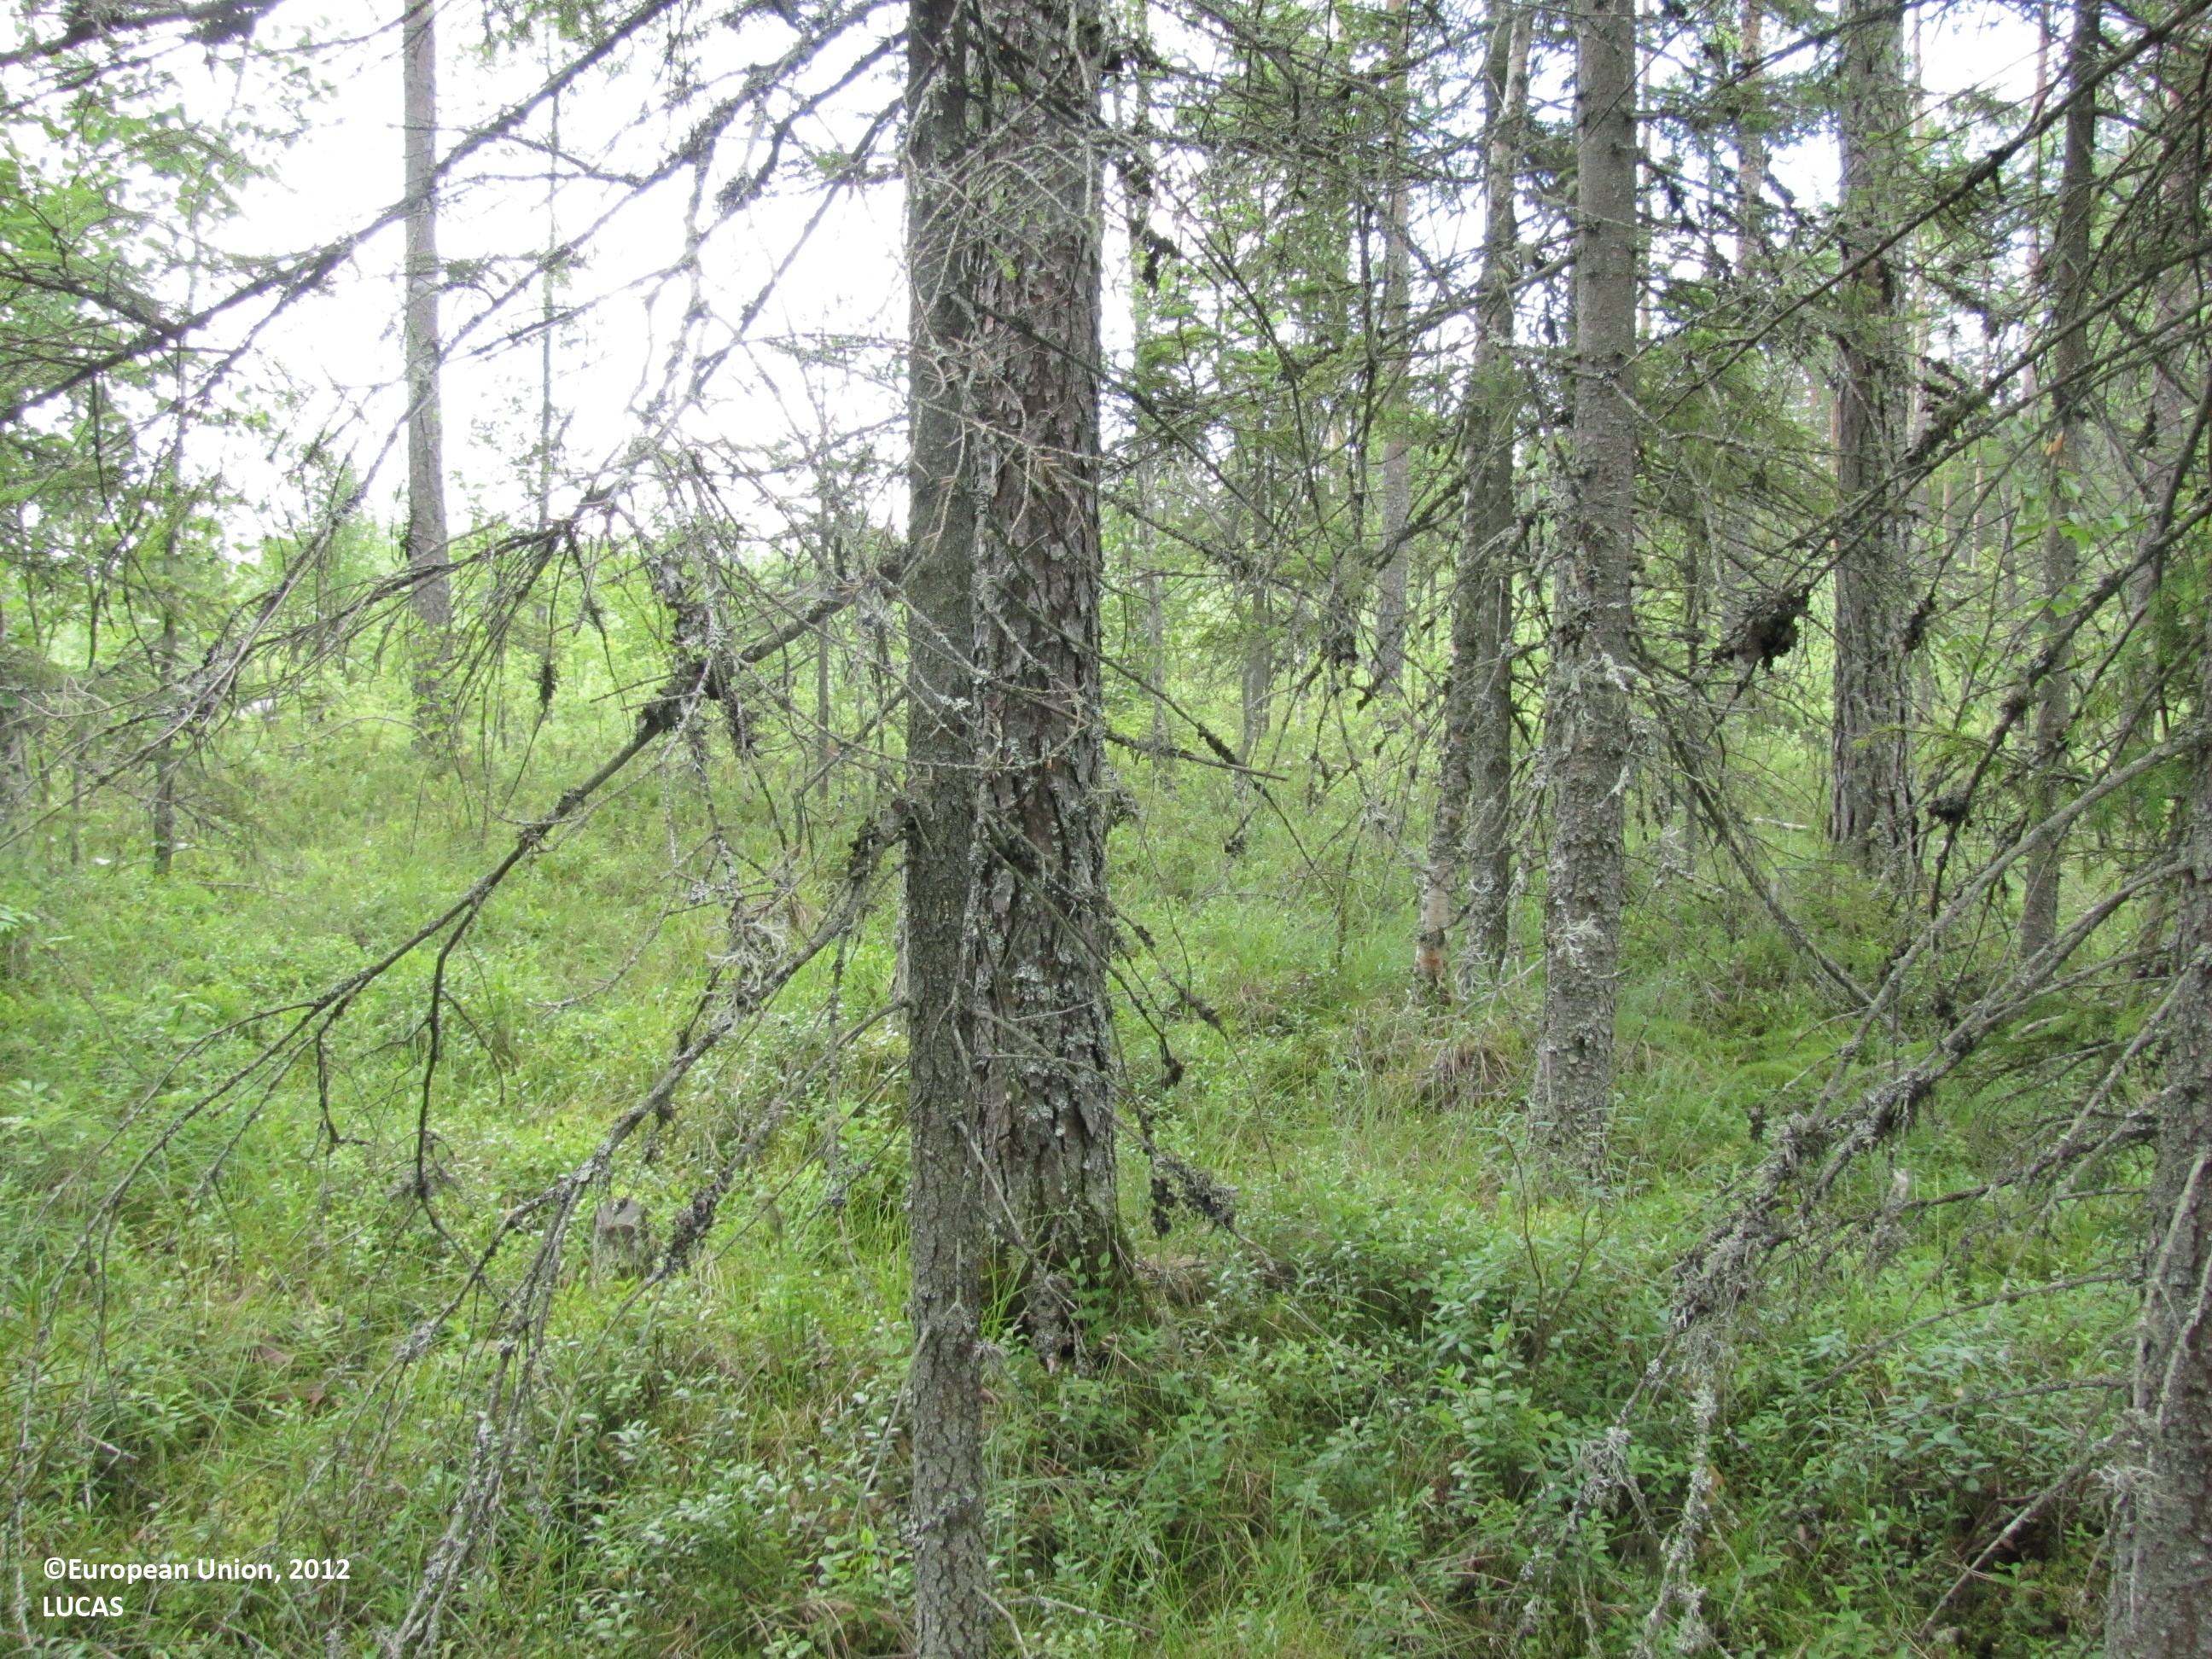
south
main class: Woodland
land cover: Pine dominated coniferous woodland
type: boreal forest
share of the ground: > 75 %
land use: Forestry
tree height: > 5 m
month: July
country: FI
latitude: 62.6631
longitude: 23.4790
